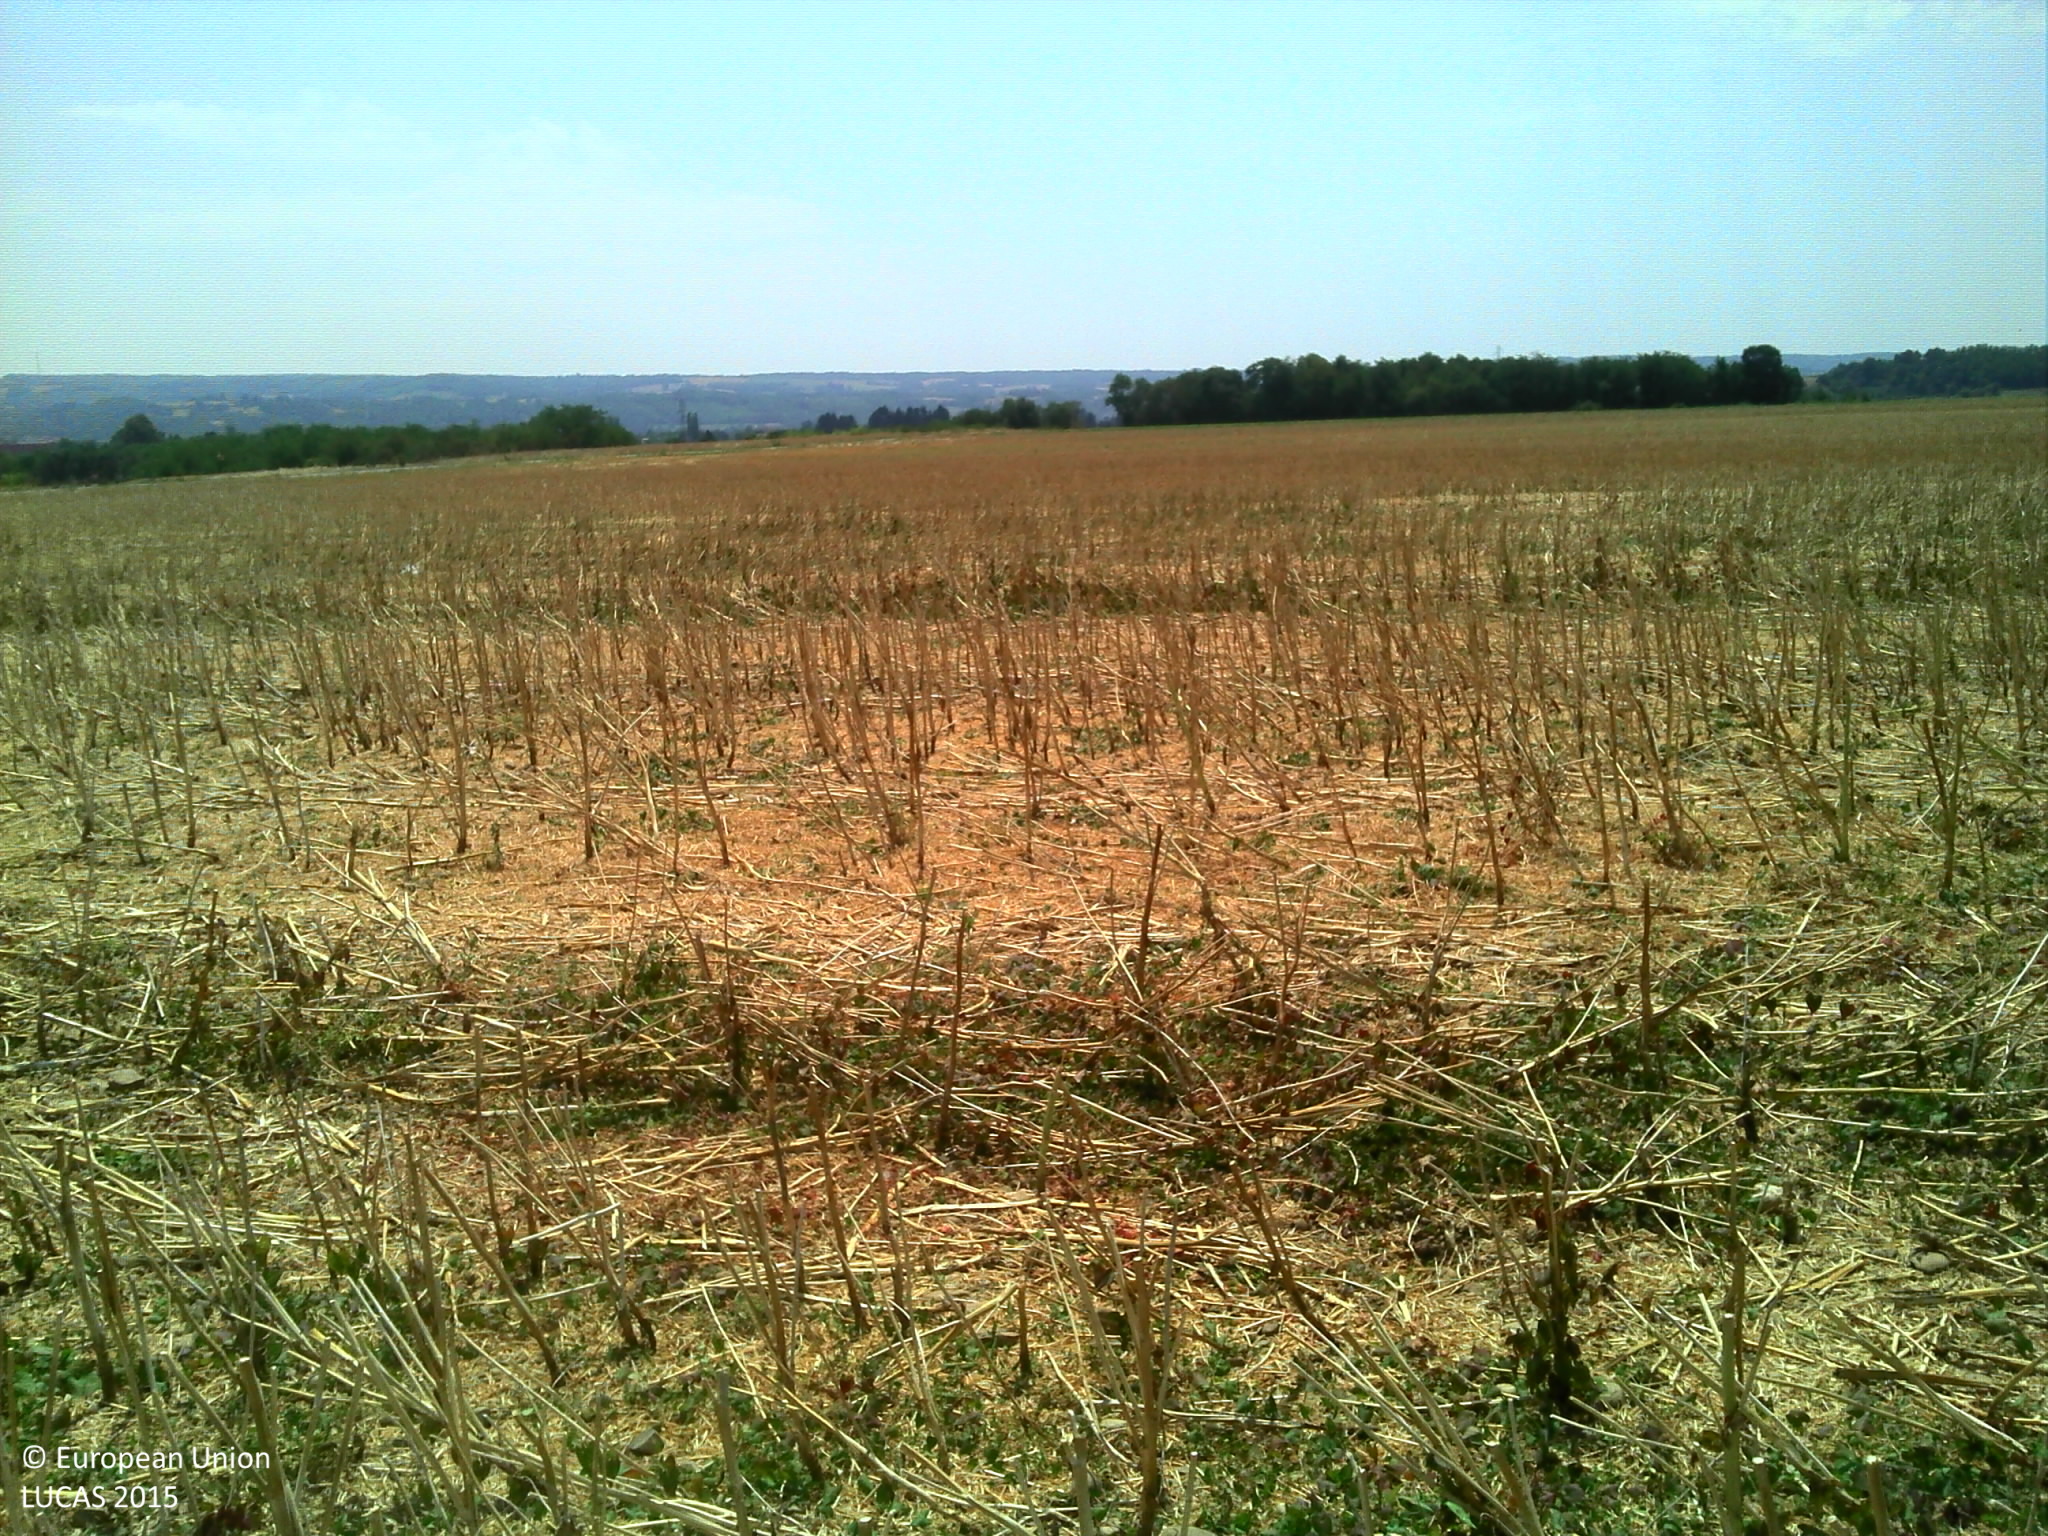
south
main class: Cropland
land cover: Rape and turnip rape
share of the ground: > 75 %
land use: Agriculture (excluding fallow land and kitchen gardens)
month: July
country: FR
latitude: 45.3588
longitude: 5.1921
